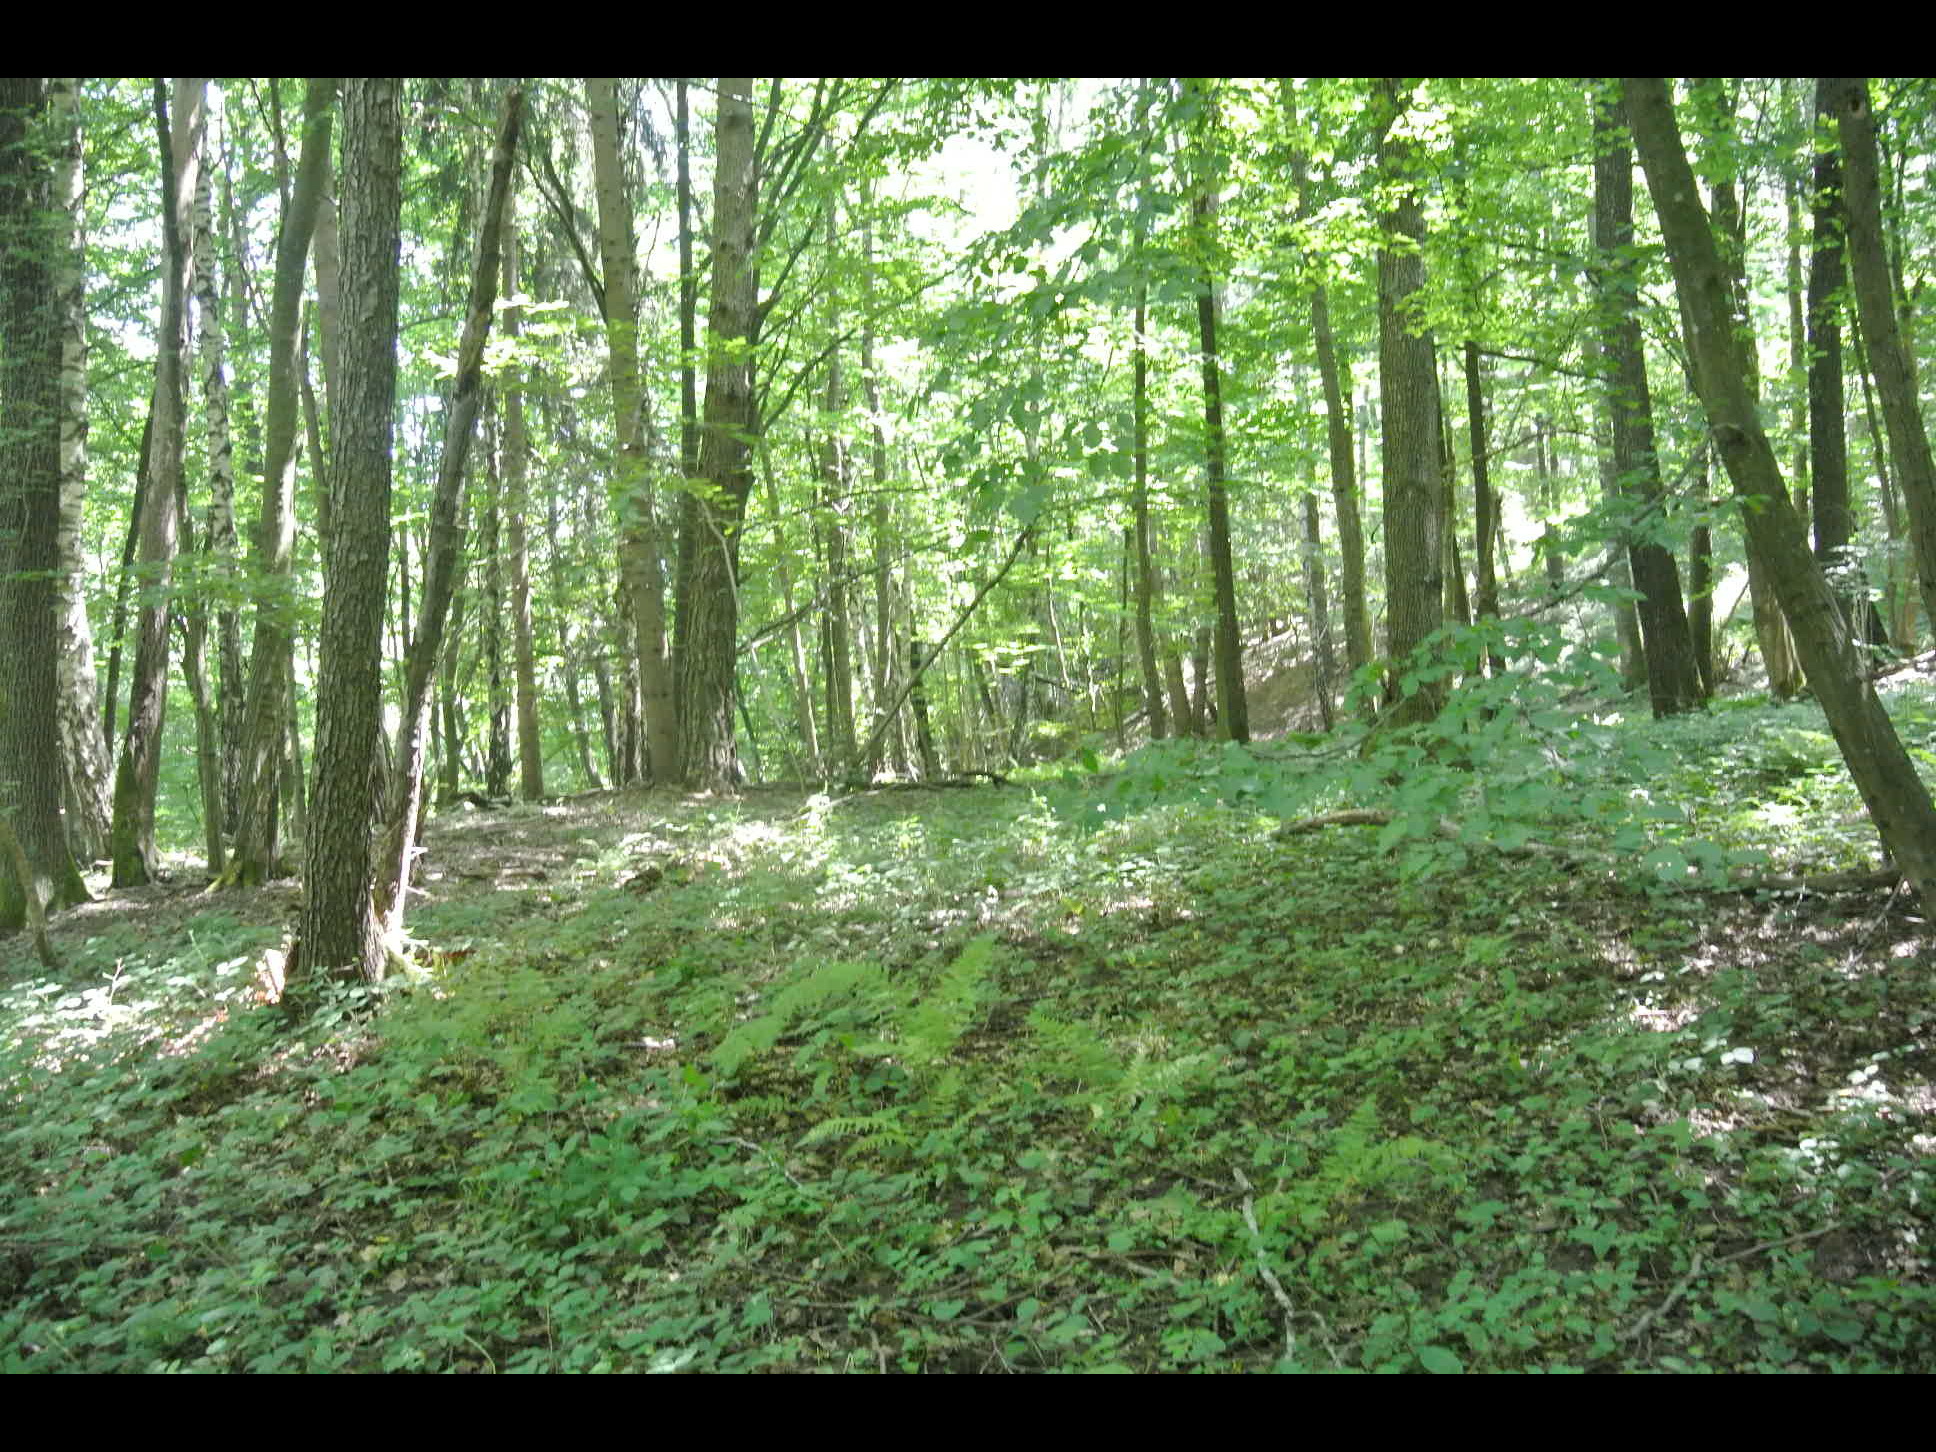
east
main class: Woodland
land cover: Broadleaved woodland
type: beech forest
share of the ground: > 75 %
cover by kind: broadleaved forest trees 90 %, herbaceous plants 10 %
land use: Forestry
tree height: > 5 m
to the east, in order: Broadleaved woodland; Tracks; Broadleaved woodland; Ditches and canals; Broadleaved woodland; Shrubland without tree cover; Artificial constructions in urban areas
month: July
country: AT
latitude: 48.0454
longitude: 15.5960
